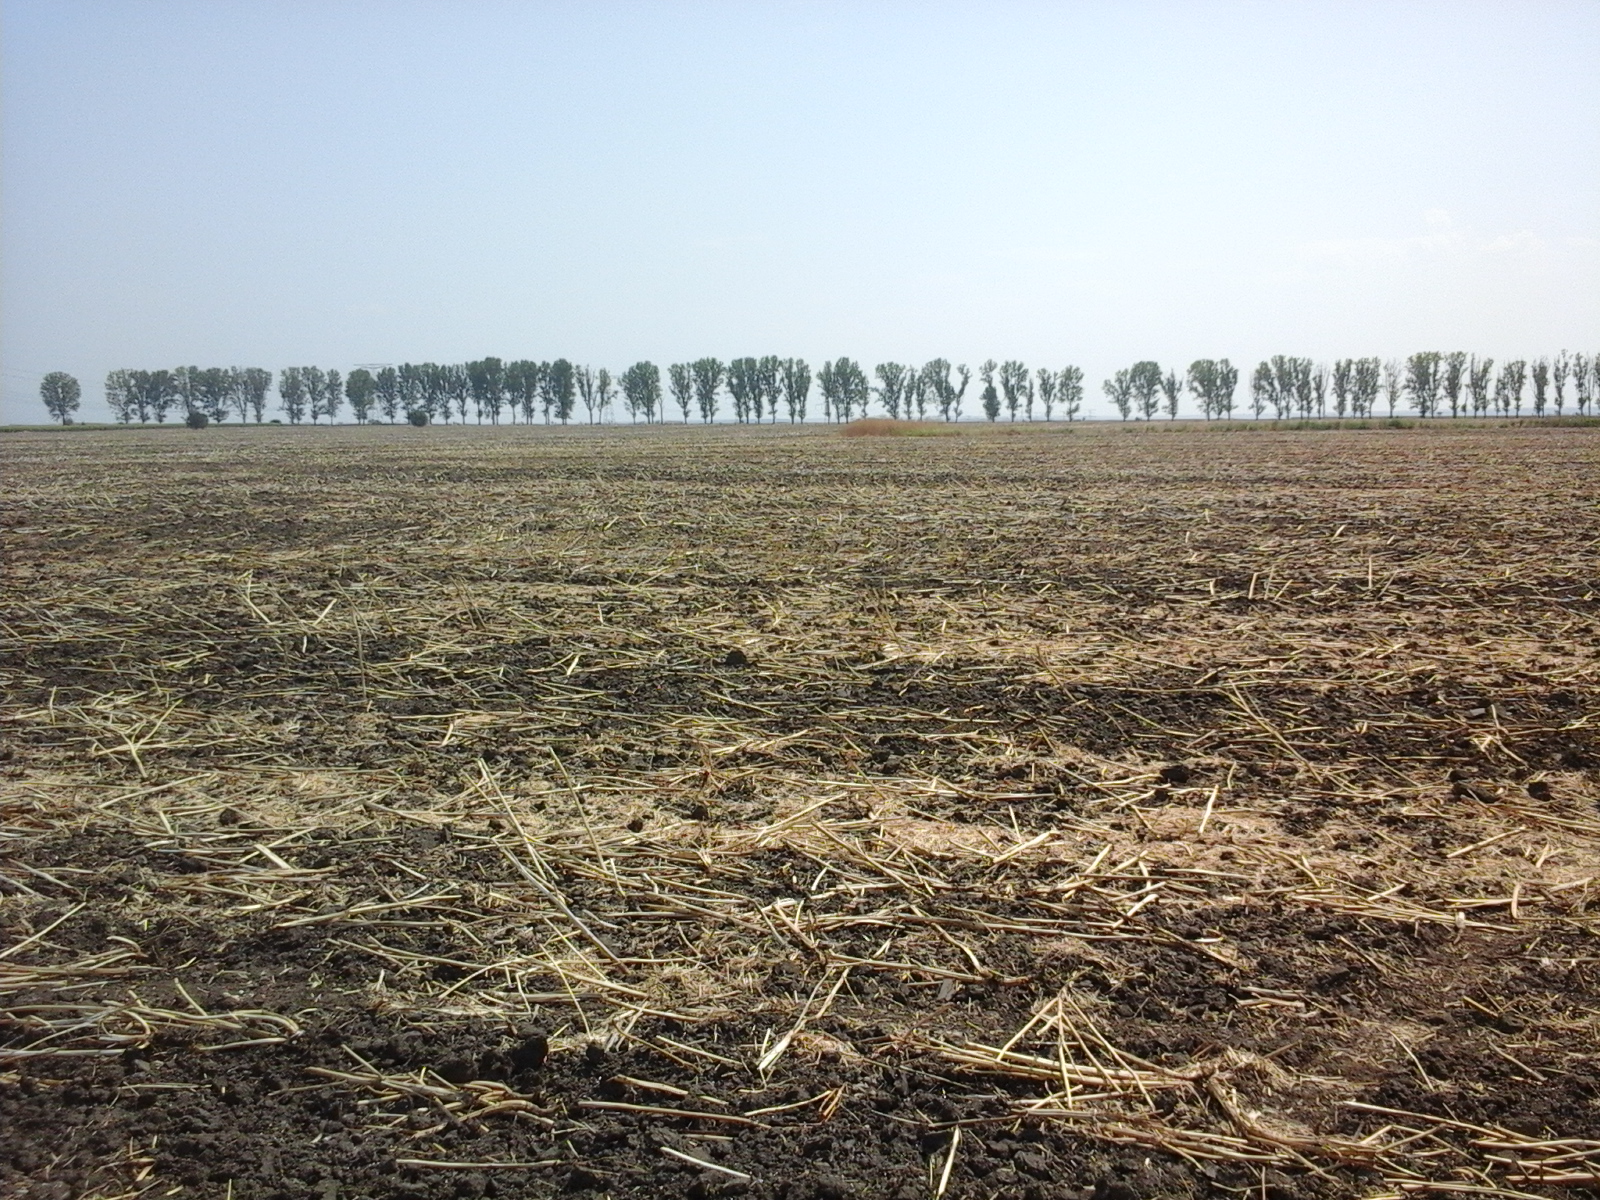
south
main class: Cropland
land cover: Rape and turnip rape
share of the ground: < 10 %
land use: Agriculture (excluding fallow land and kitchen gardens)
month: August
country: RO
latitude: 43.9203
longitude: 23.6382
